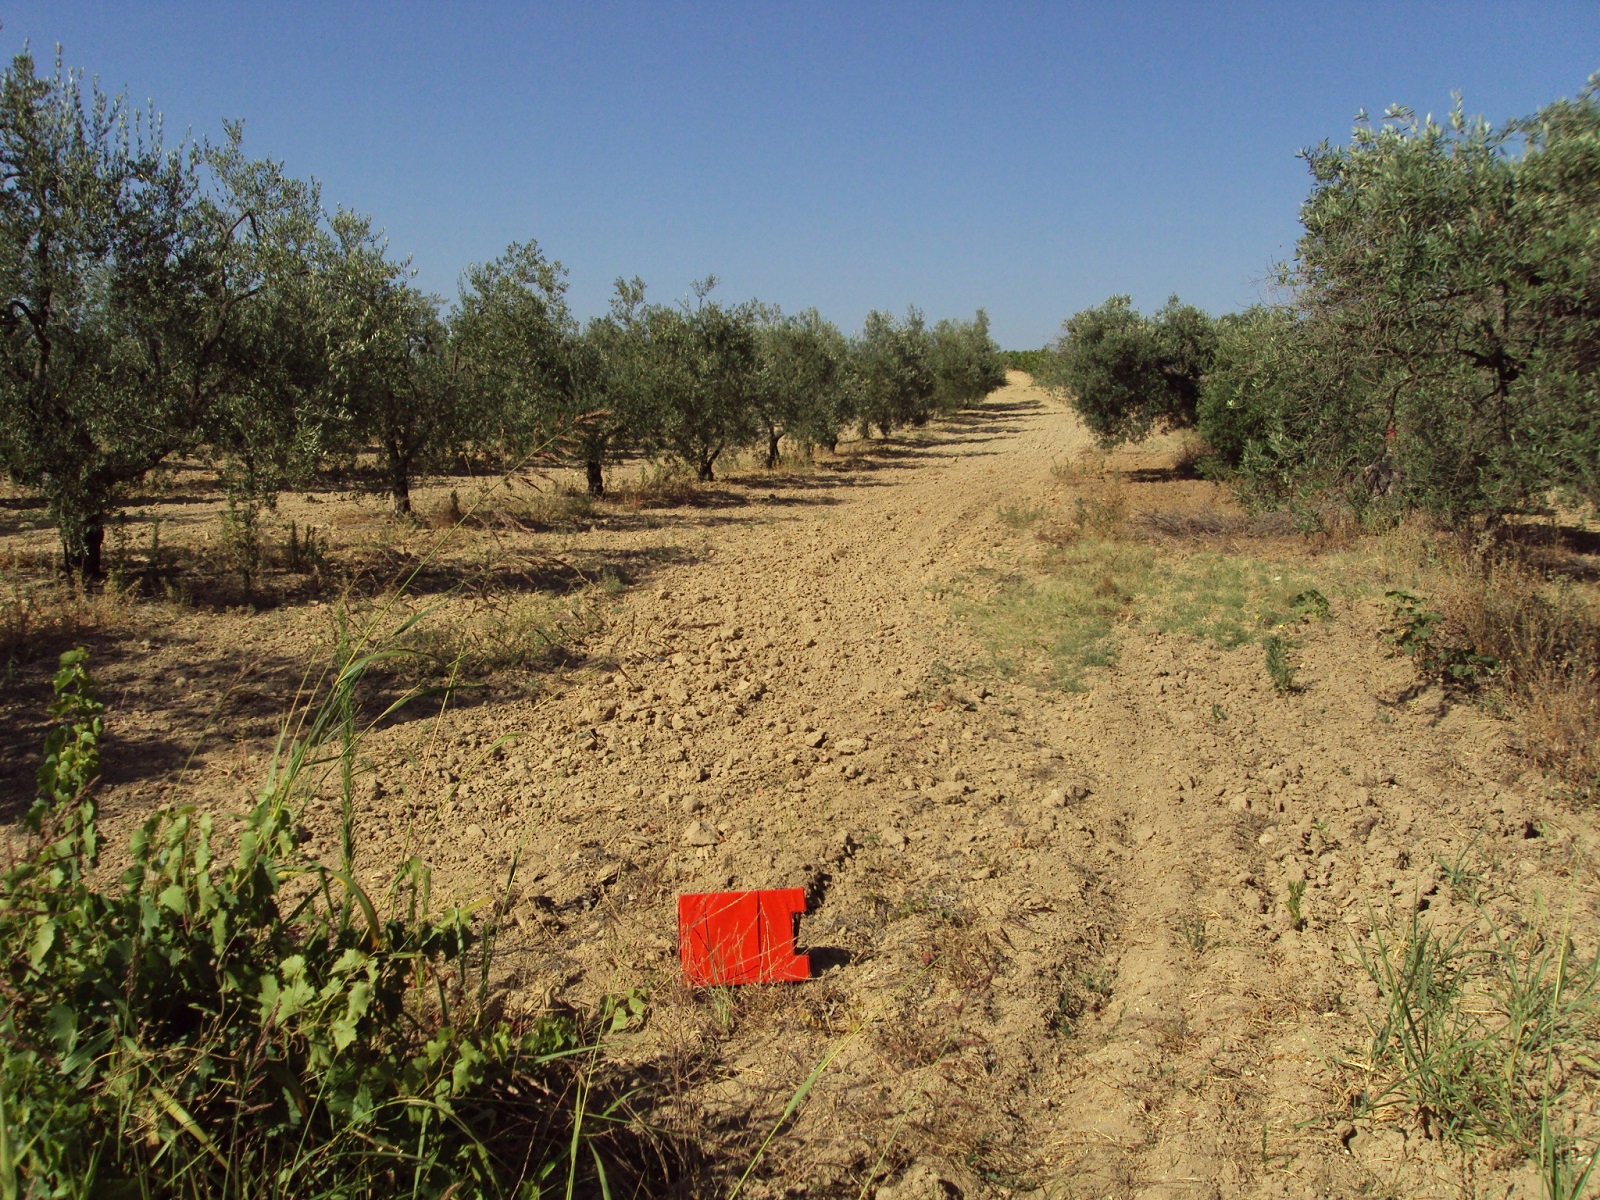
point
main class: Cropland
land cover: Olive groves
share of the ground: 25 - 50 %
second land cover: Spontaneously vegetated surfaces
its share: > 75 %
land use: Agriculture (excluding fallow land and kitchen gardens)
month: June
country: ES
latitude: 37.3277
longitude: -6.6119
